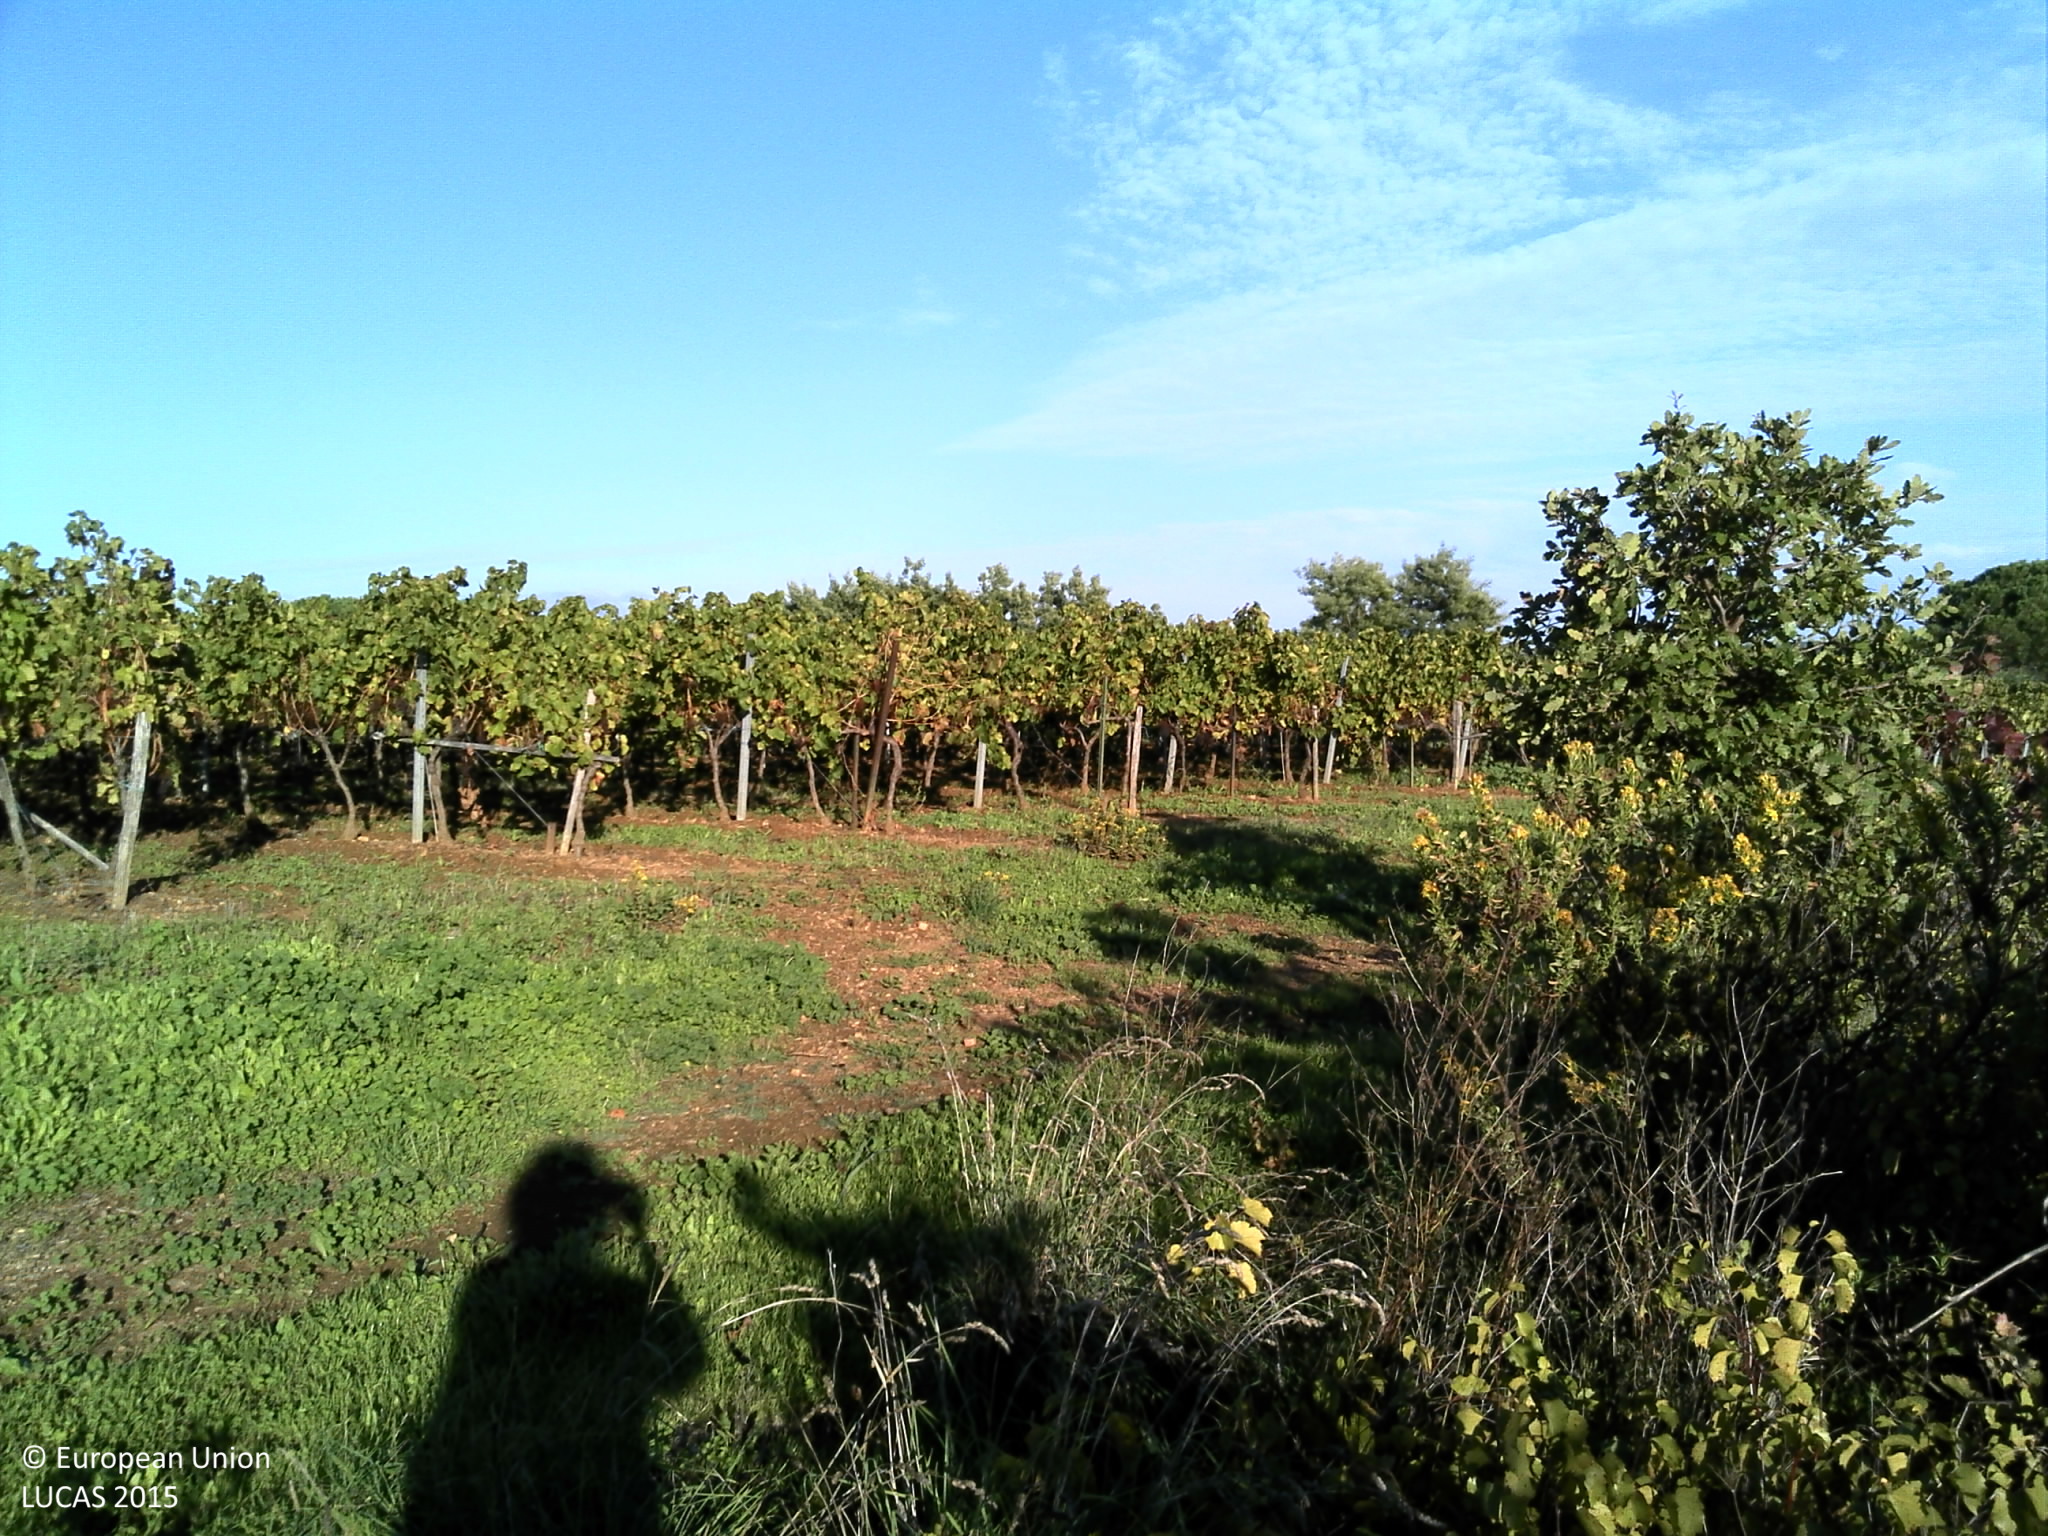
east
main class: Grassland
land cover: Spontaneously vegetated surfaces
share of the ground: > 75 %
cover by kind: herbaceous plants 95 %, shrubs 5 %
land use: Abandoned areas
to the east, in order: Spontaneously vegetated surfaces; Tracks; Vineyards; Artificial constructions in urban areas
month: October
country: FR
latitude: 43.2449
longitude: 6.5237
